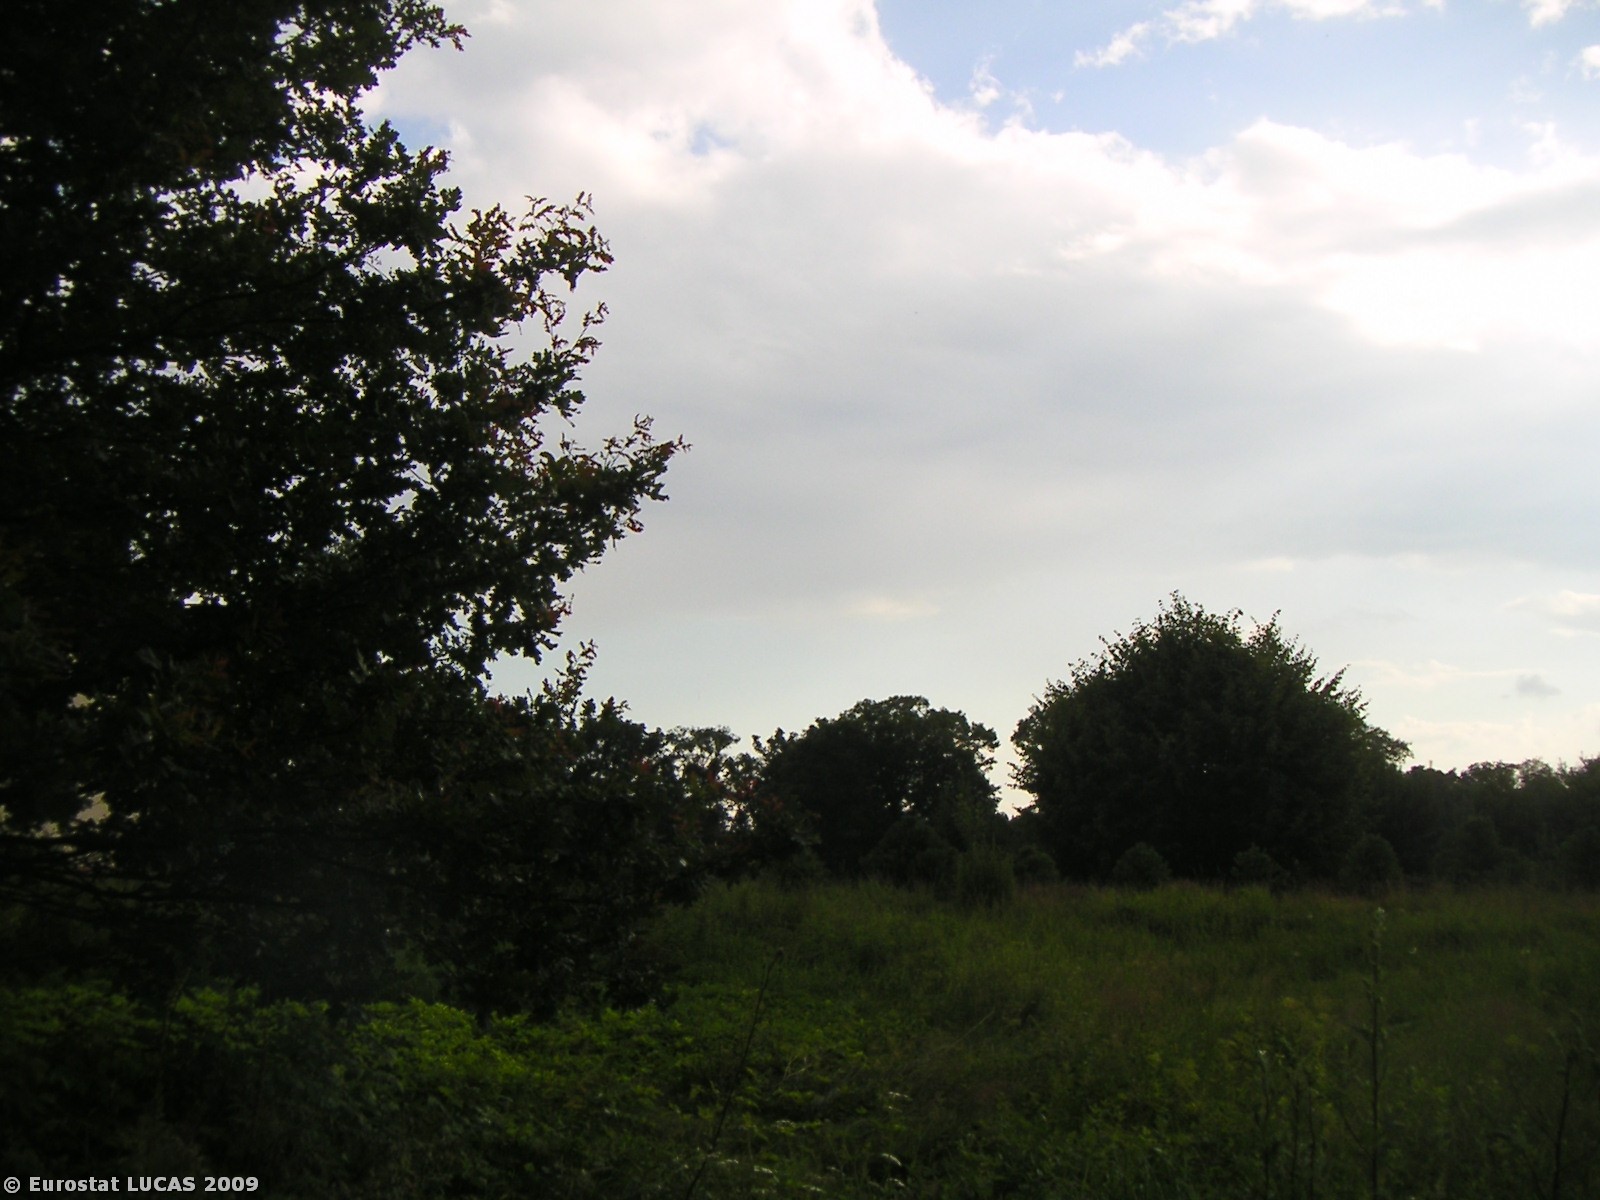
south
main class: Grassland
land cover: Grassland with sparse tree/shrub cover
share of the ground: > 75 %
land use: Agriculture (excluding fallow land and kitchen gardens)
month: July
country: PL
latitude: 50.0821
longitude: 18.7553
